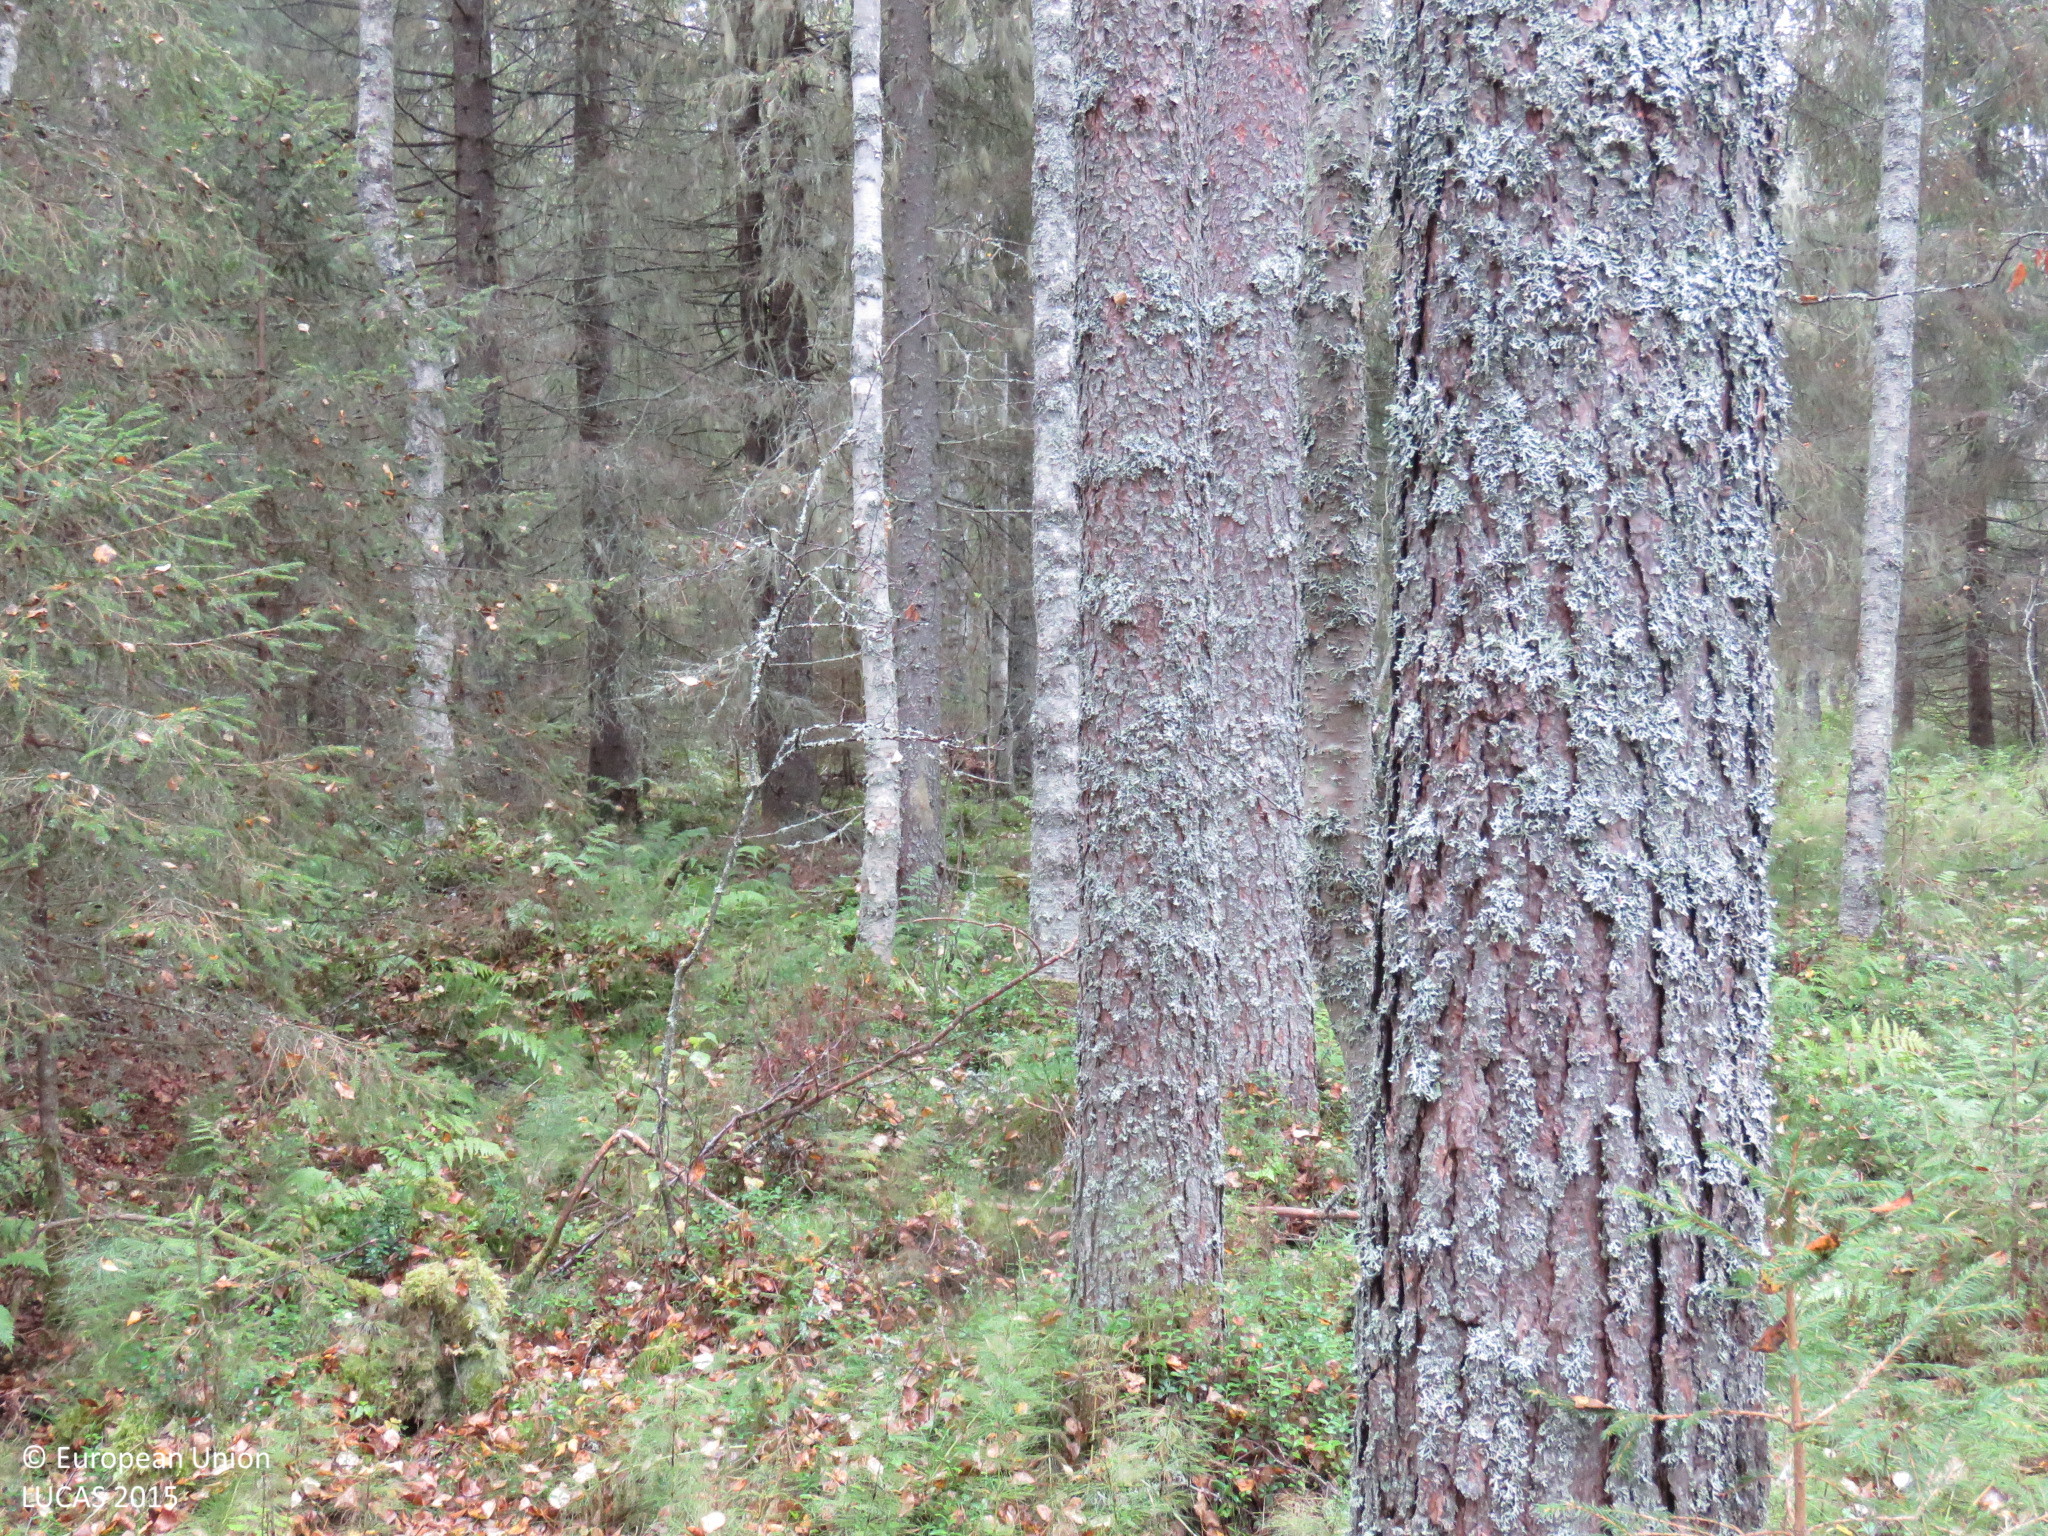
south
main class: Woodland
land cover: Other mixed woodland
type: boreal forest
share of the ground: > 75 %
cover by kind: coniferous forest trees 65 %, broadleaved forest trees 25 %, shrubs 5 %, herbaceous plants 5 %
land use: Forestry
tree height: > 5 m
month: September
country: FI
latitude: 64.8785
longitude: 26.6867
